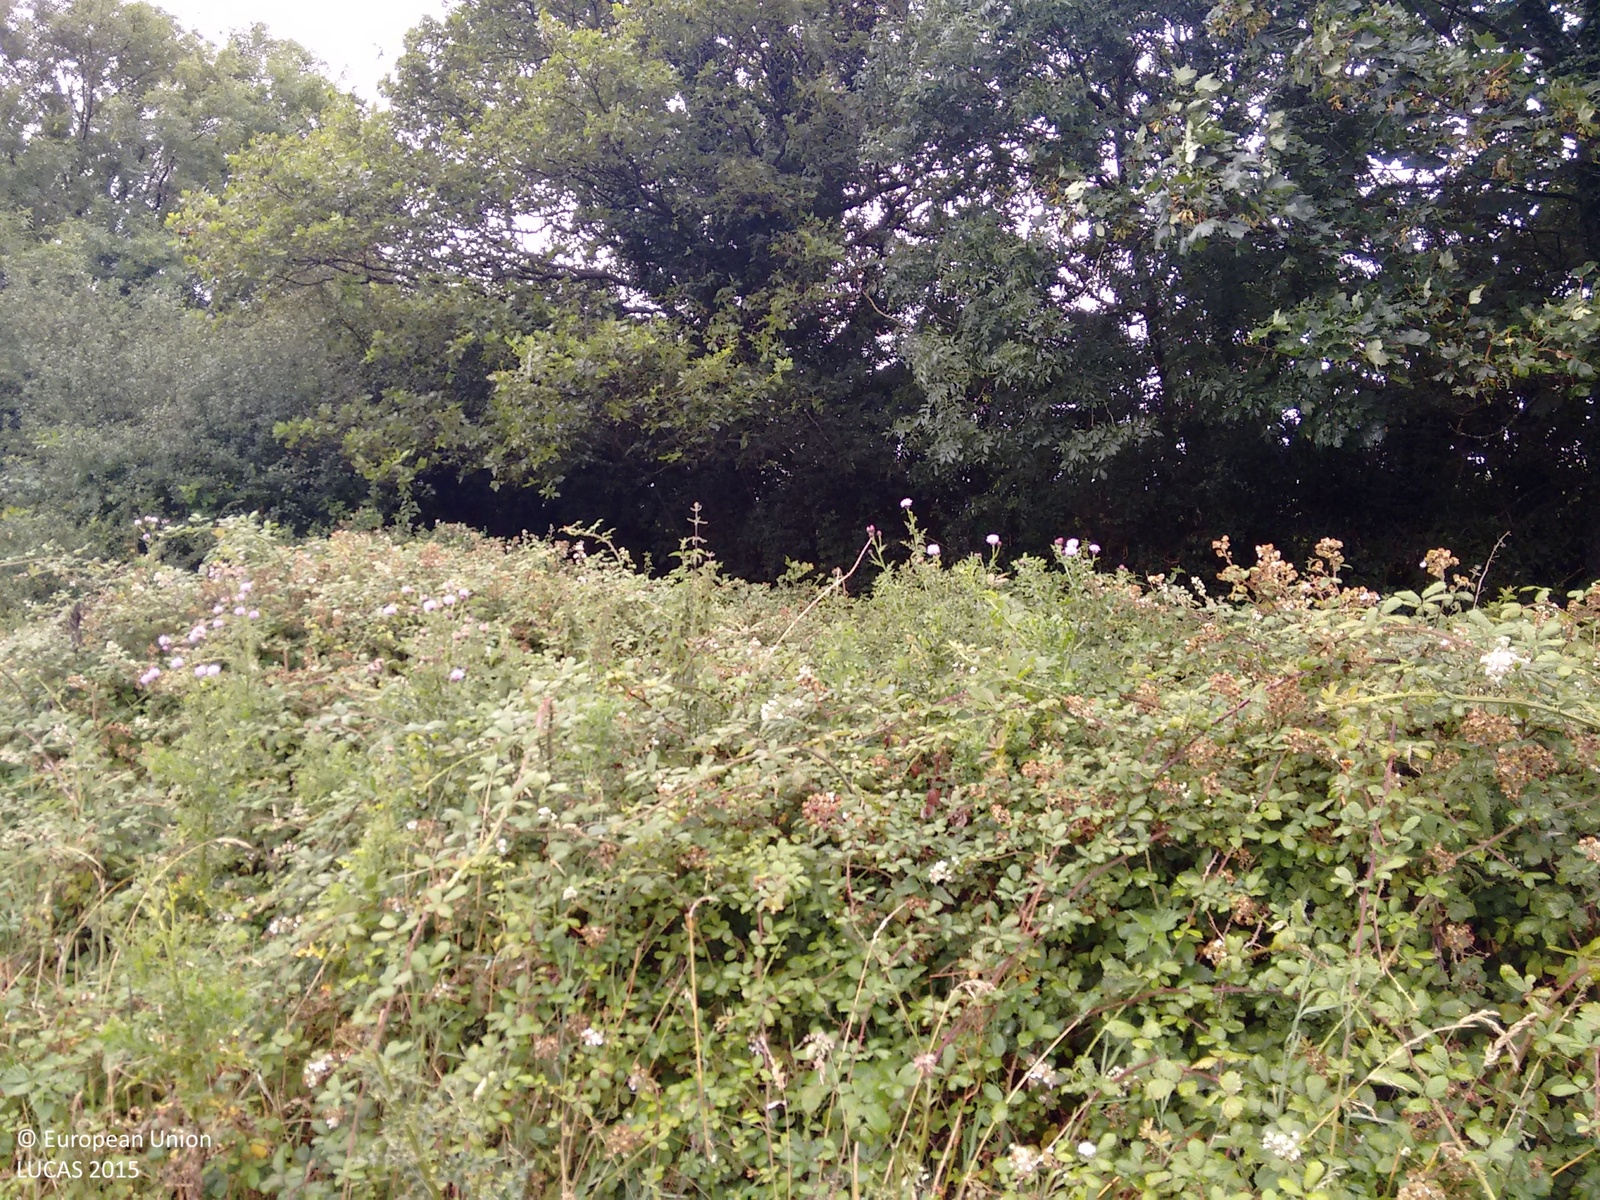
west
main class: Shrubland
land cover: Shrubland with sparse tree cover
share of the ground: > 75 %
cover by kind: shrubs 95 %, broadleaved forest trees 5 %
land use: Agriculture (excluding fallow land and kitchen gardens)
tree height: < 5 m
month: August
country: GB
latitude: 53.1373
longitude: -4.2555
